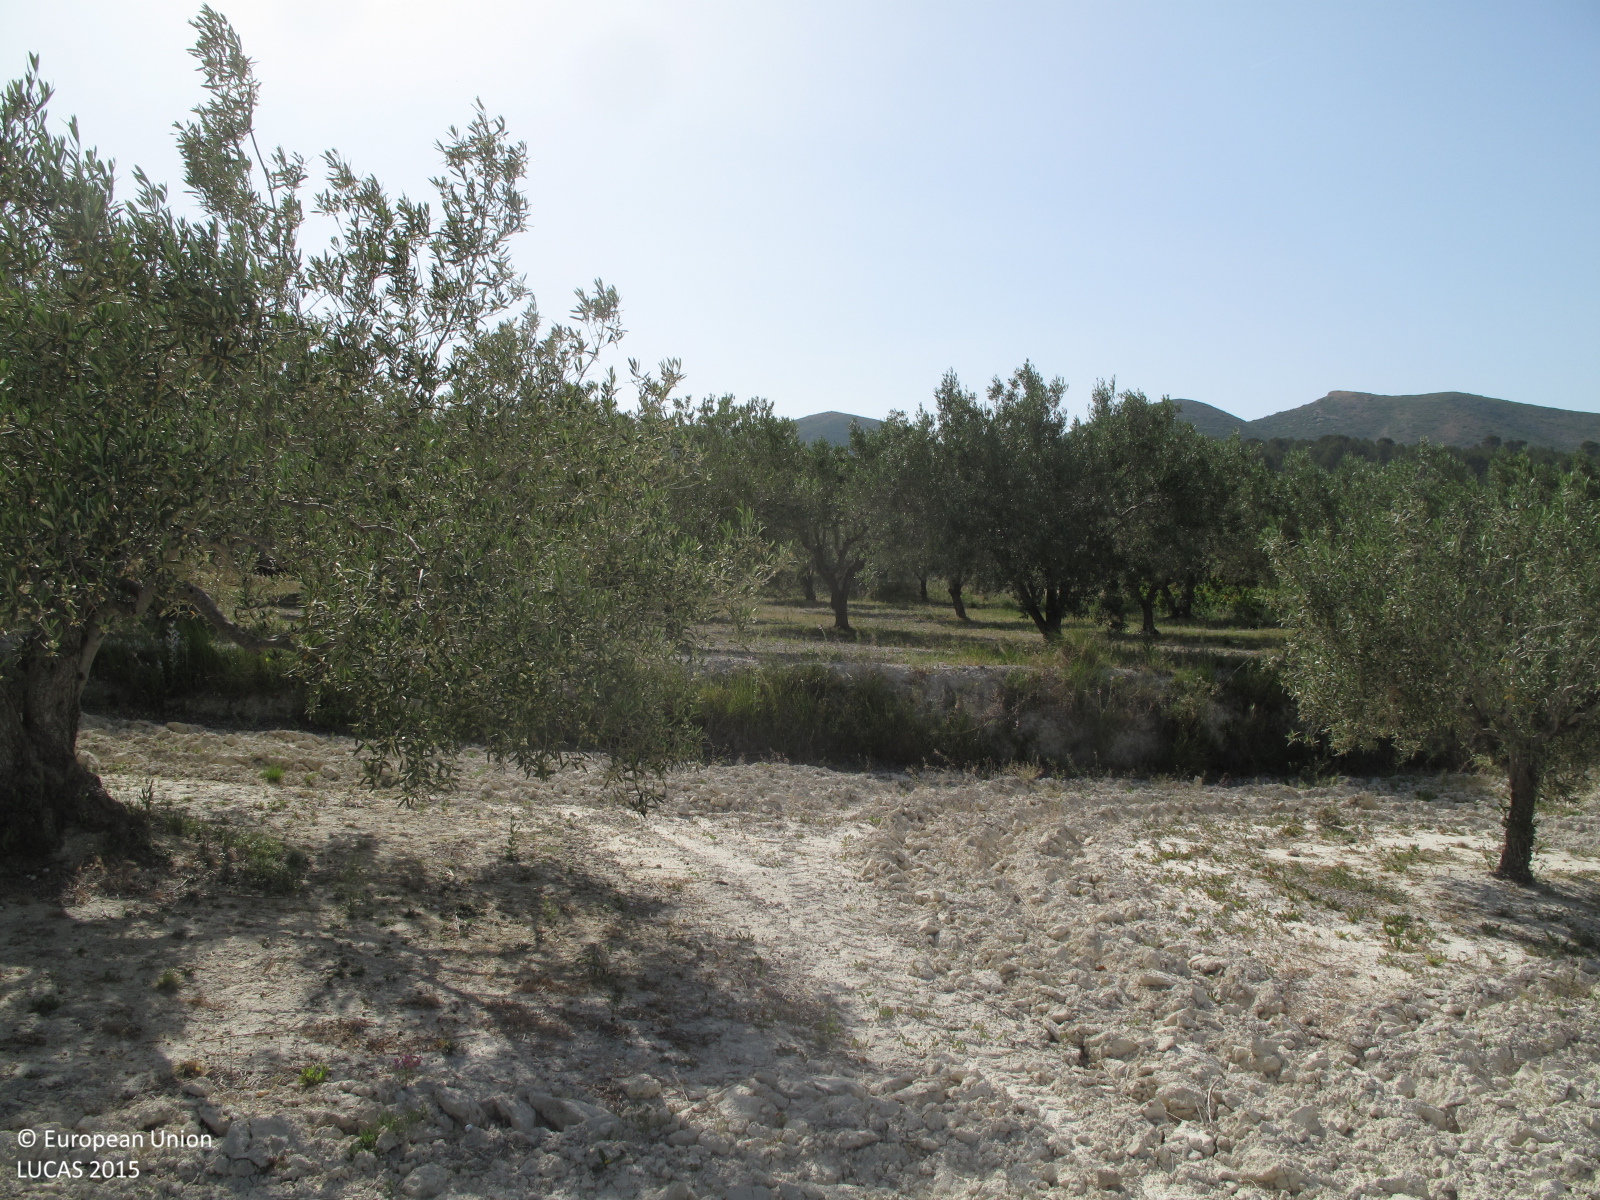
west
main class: Cropland
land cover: Olive groves
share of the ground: 25 - 50 %
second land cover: Spontaneously vegetated surfaces
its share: > 75 %
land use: Agriculture (excluding fallow land and kitchen gardens)
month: May
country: ES
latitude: 38.9106
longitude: -0.5671
